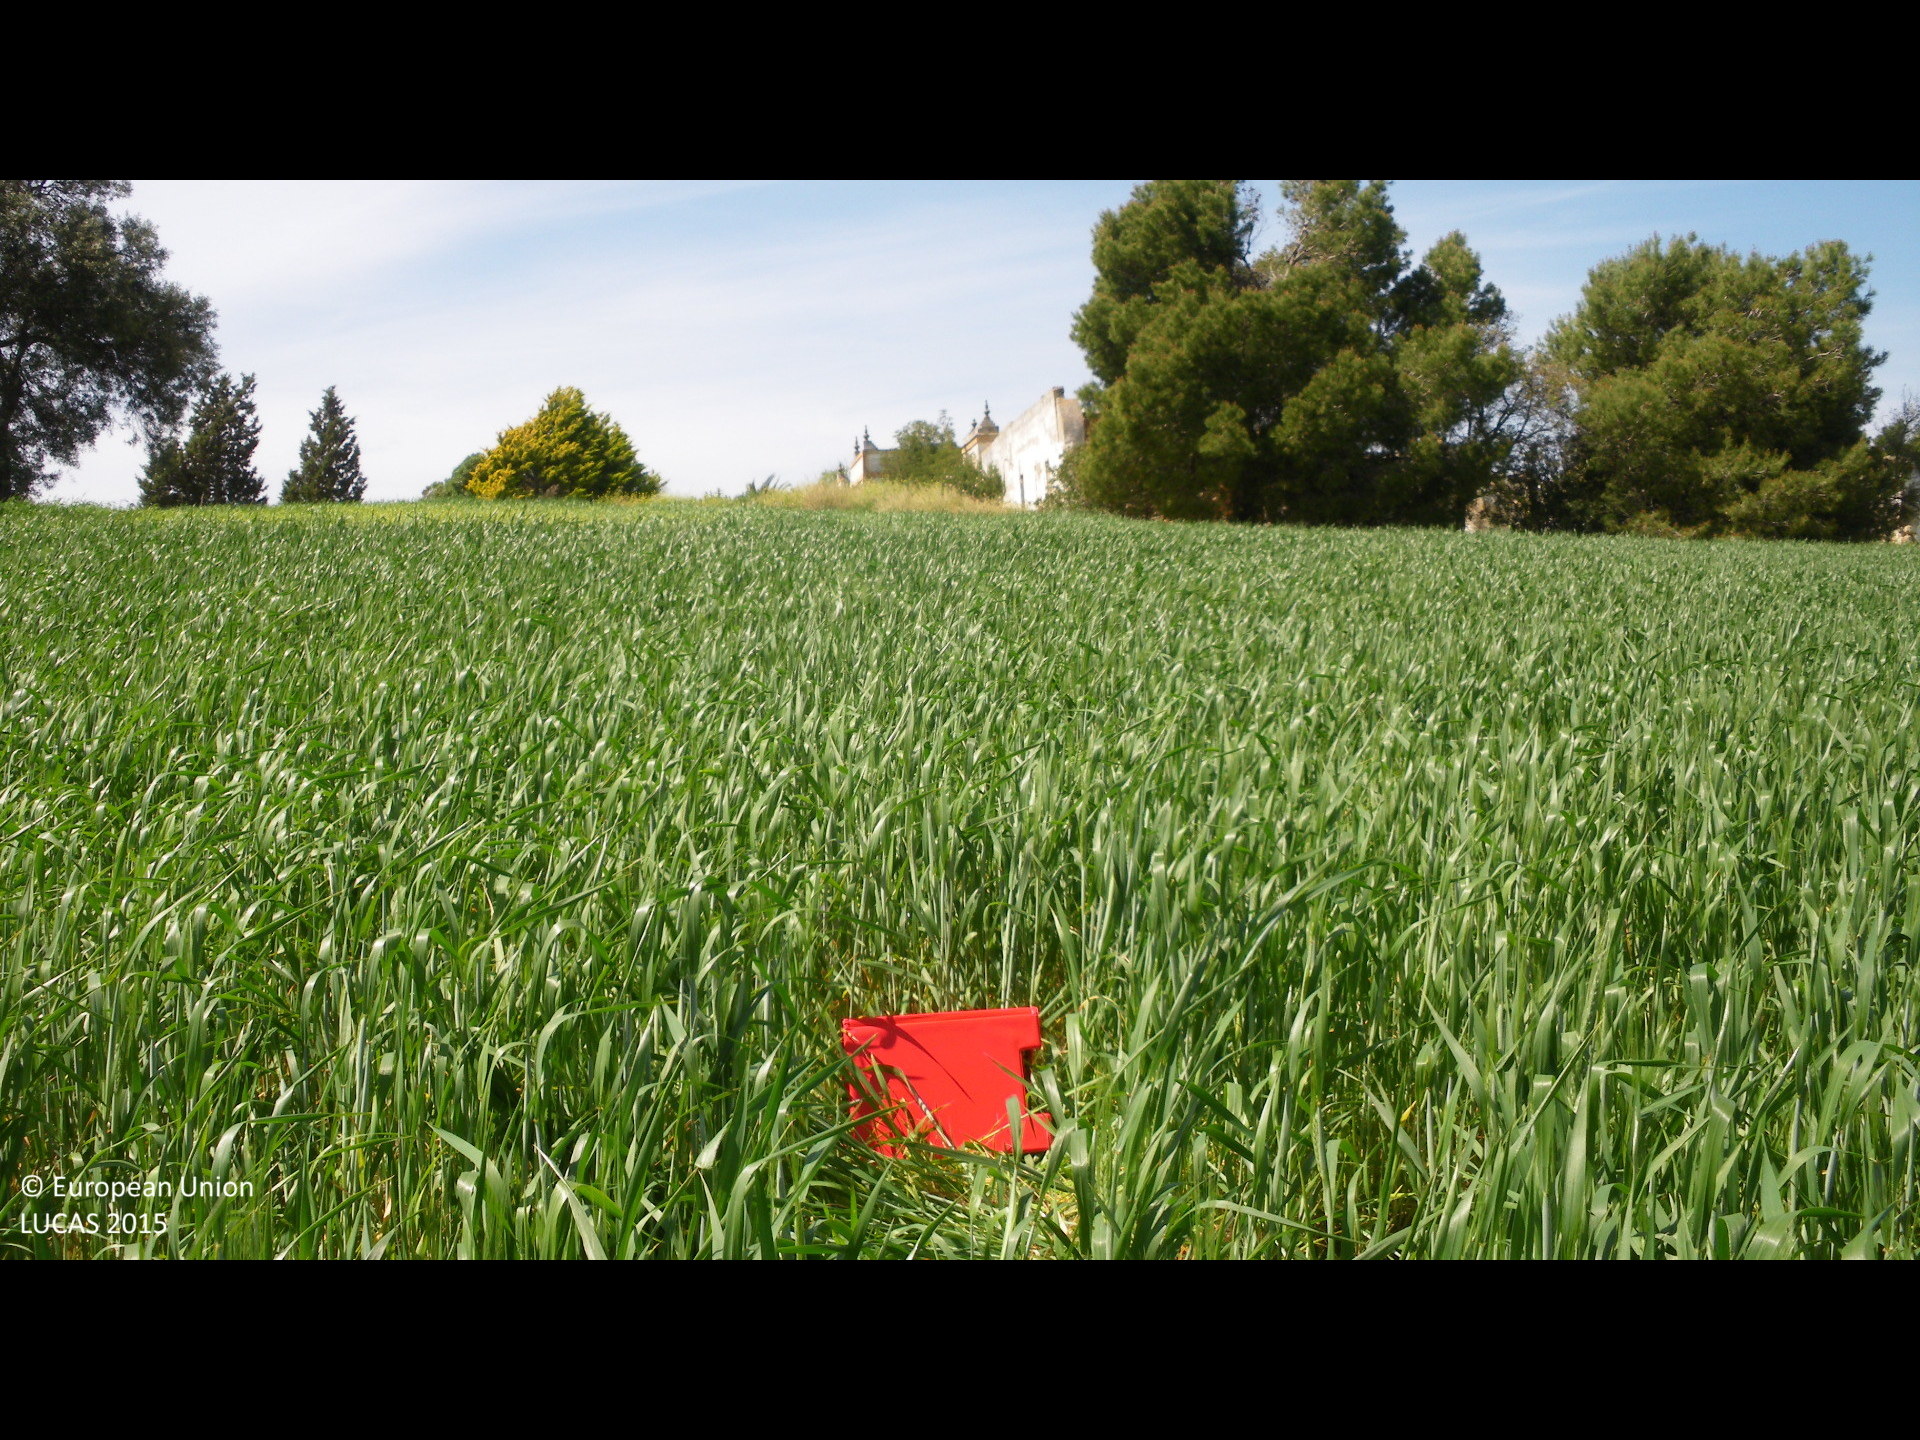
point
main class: Cropland
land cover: Common wheat
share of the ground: > 75 %
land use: Agriculture (excluding fallow land and kitchen gardens)
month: April
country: ES
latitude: 36.6442
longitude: -6.1972
